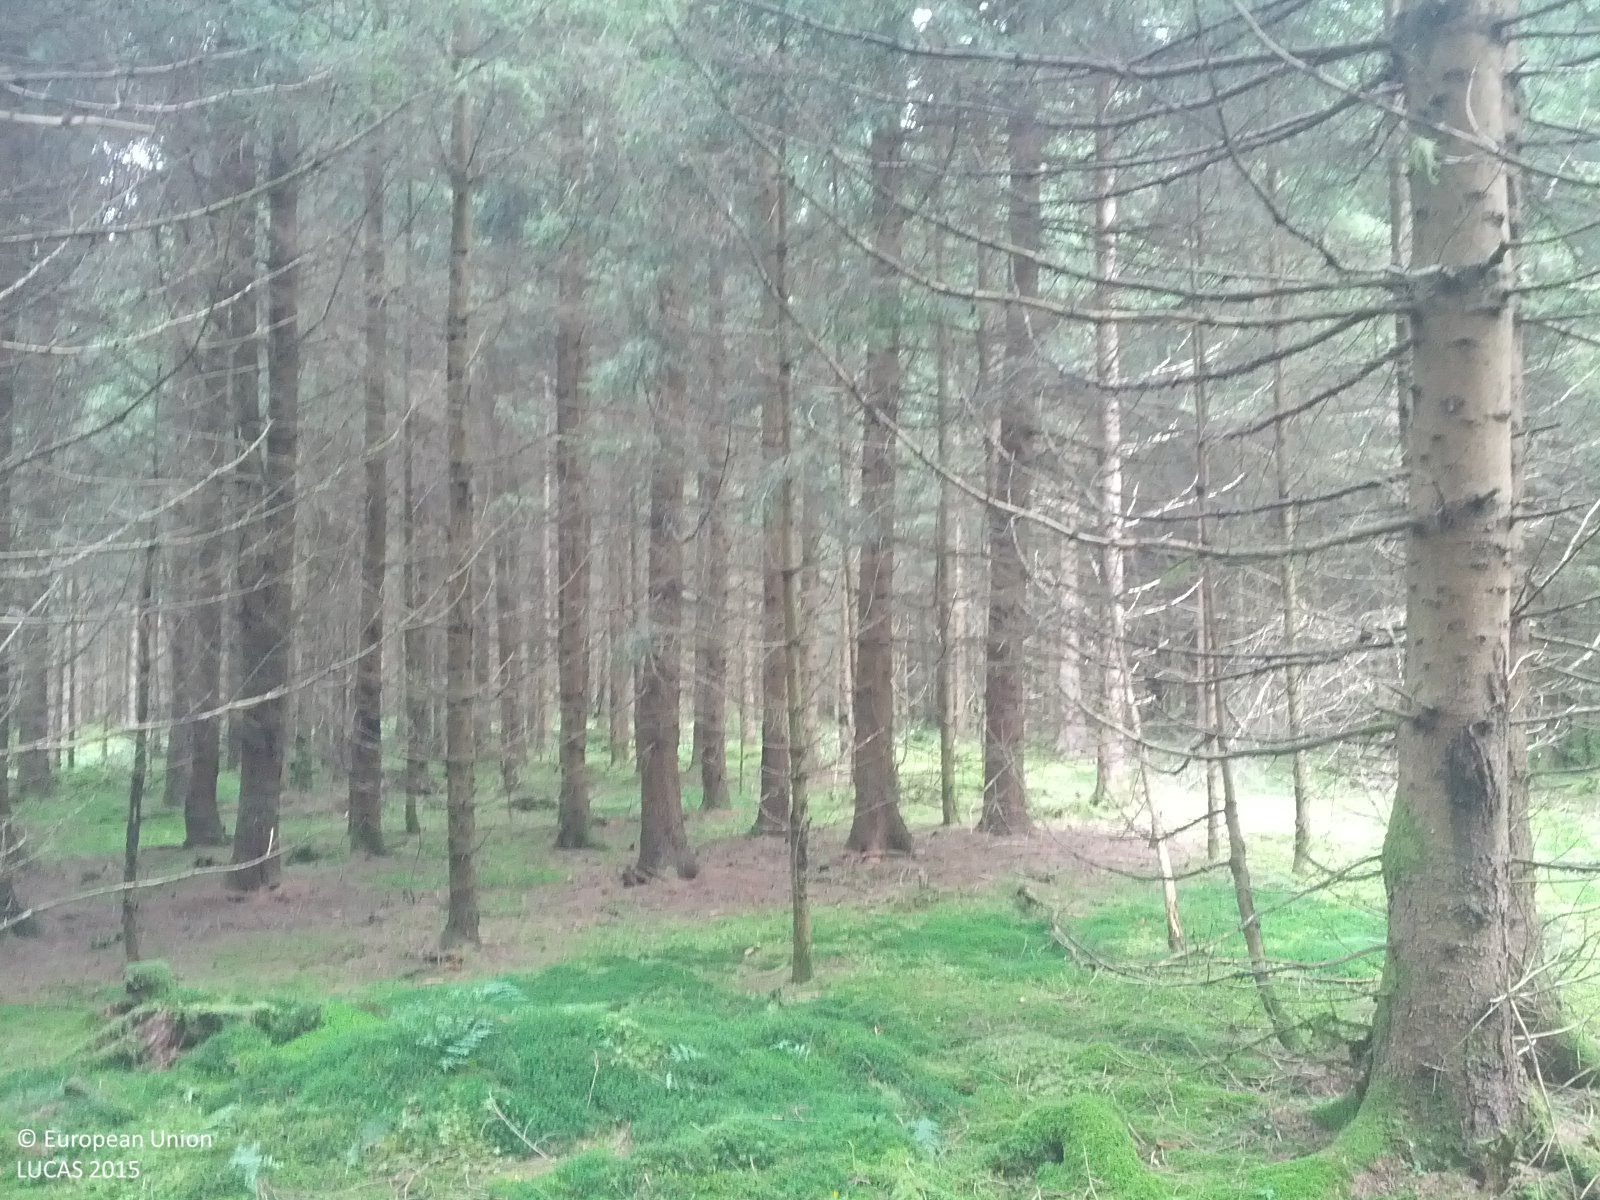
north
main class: Woodland
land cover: Spruce dominated coniferous woodland
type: alpine coniferous forest
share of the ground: > 75 %
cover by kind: coniferous forest trees 75 %, lichens and mosses 15 %, shrubs 5 %, herbaceous plants 5 %
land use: Forestry
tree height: > 5 m
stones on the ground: 25 - 50 %
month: September
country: AT
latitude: 48.1138
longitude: 12.8868
